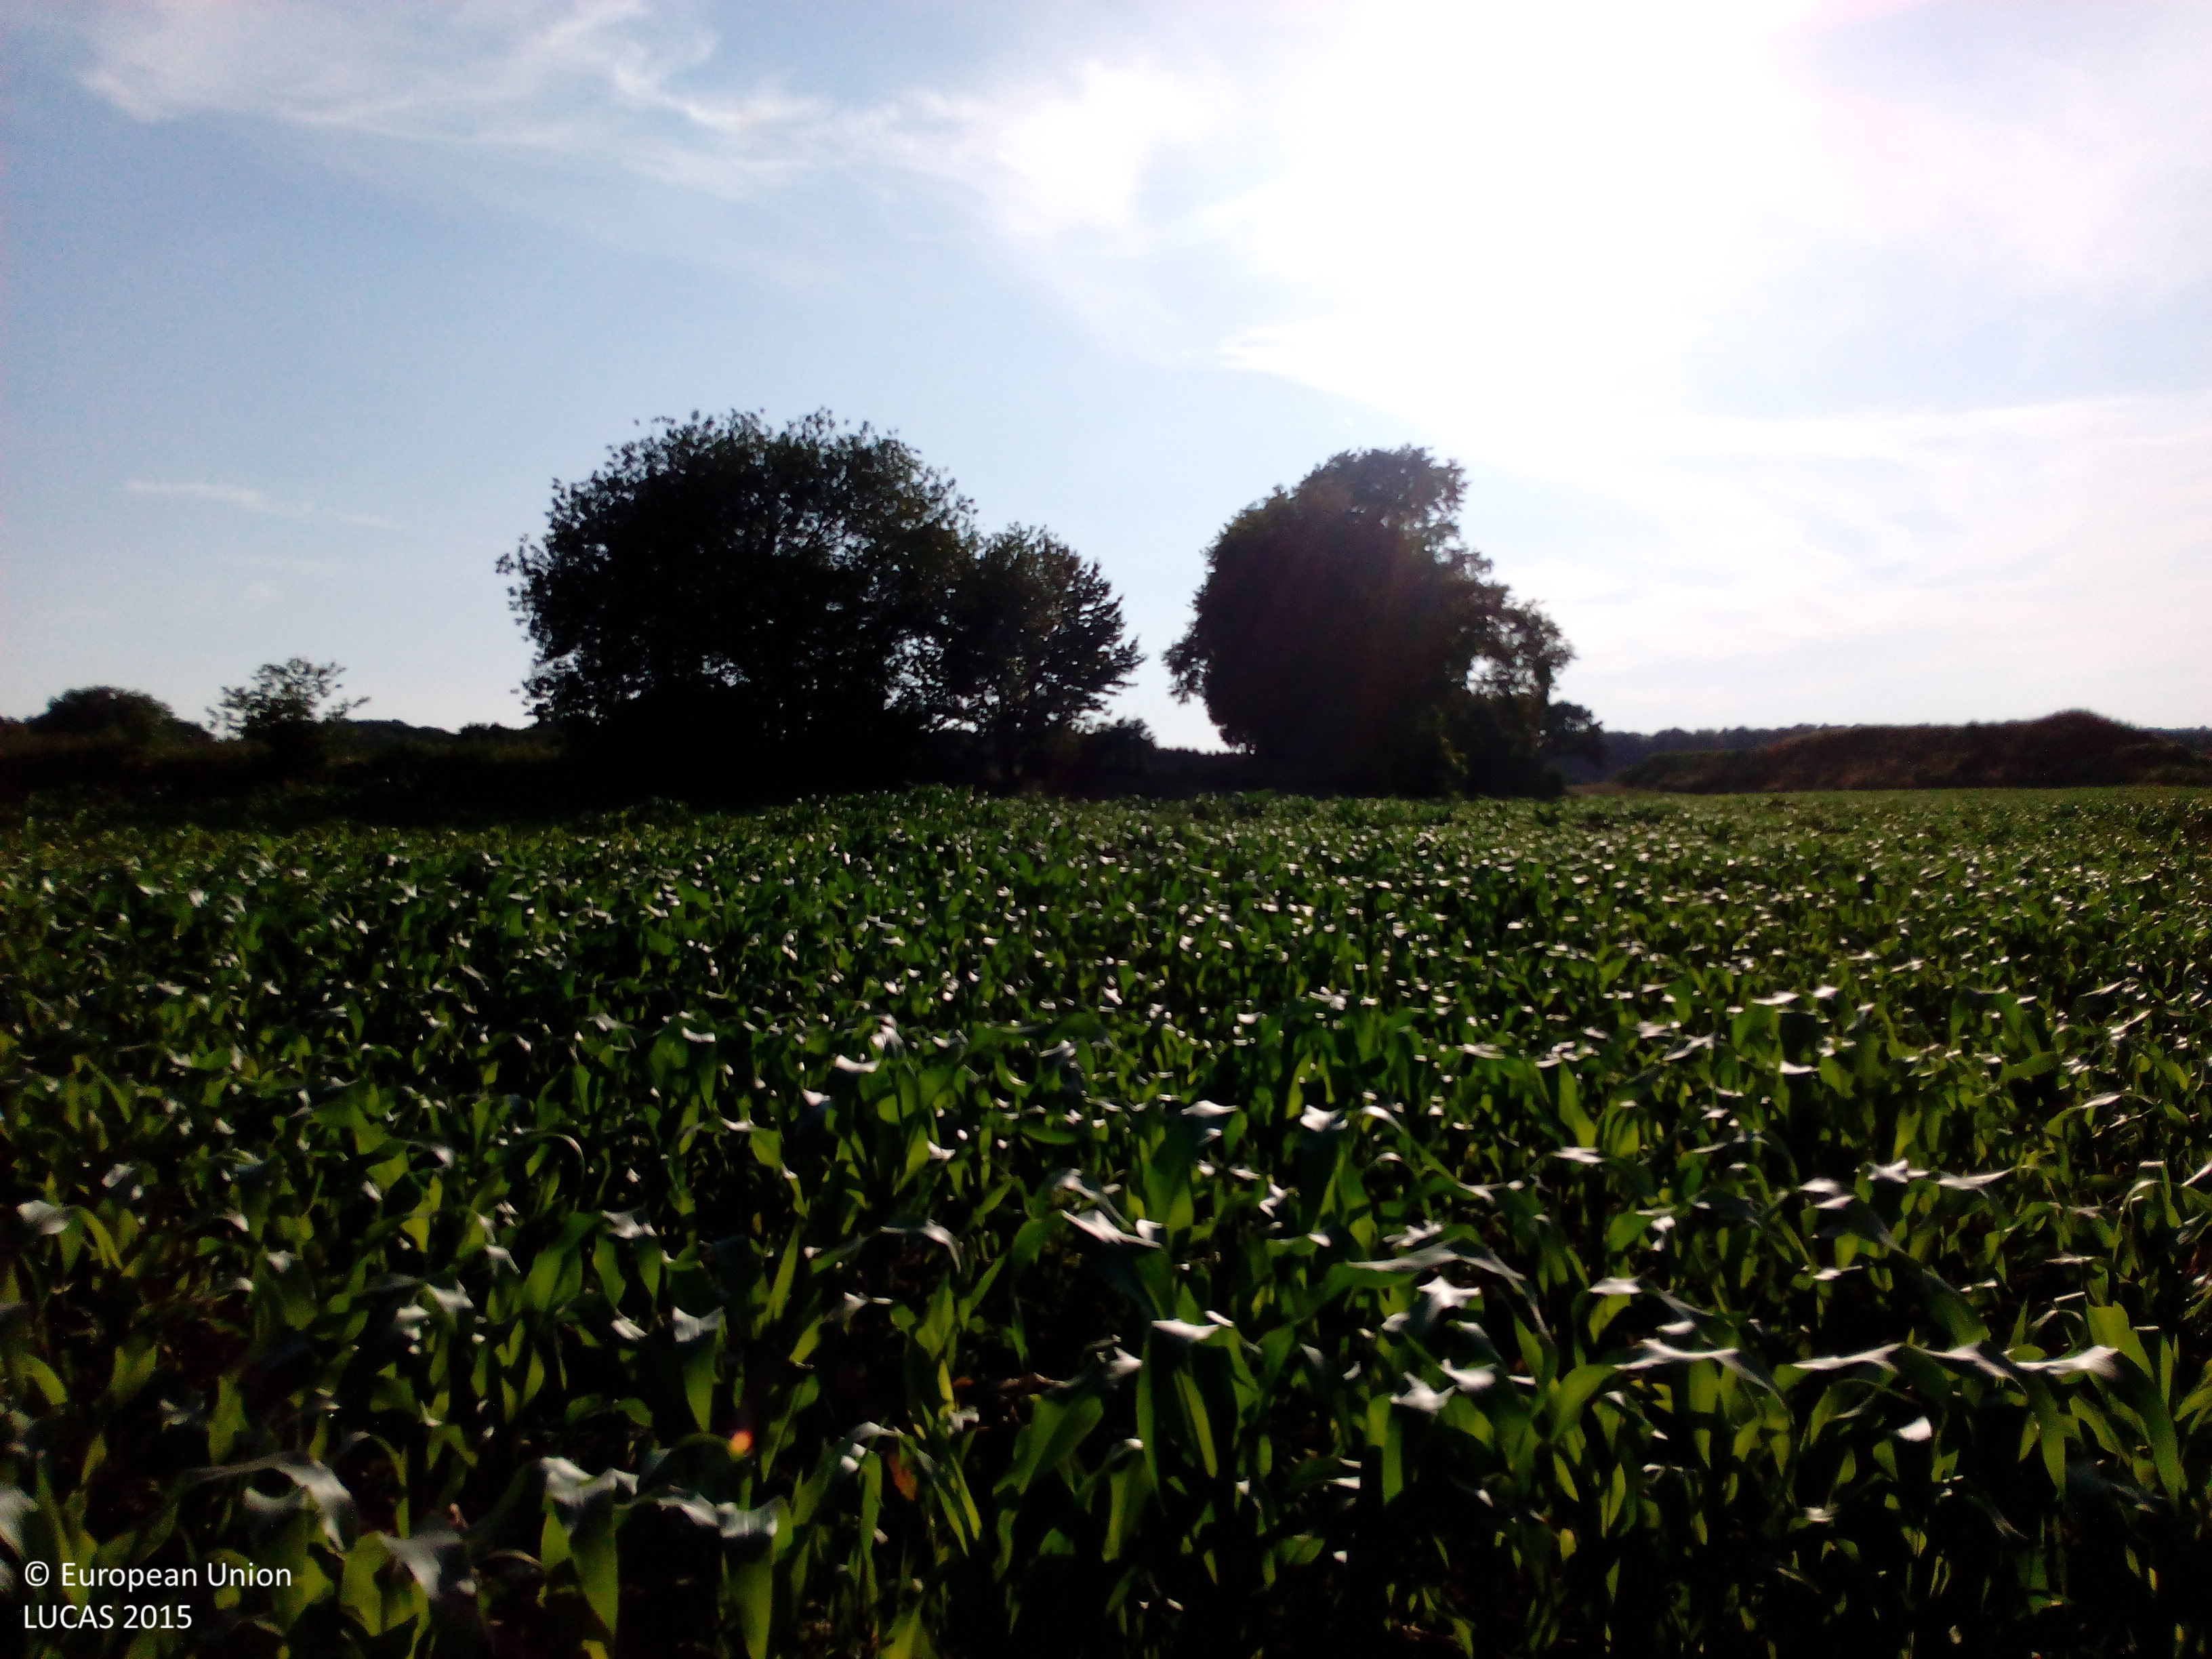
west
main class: Cropland
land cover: Maize
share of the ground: > 75 %
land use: Agriculture (excluding fallow land and kitchen gardens)
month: July
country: DE
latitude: 52.5216
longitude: 7.9519
